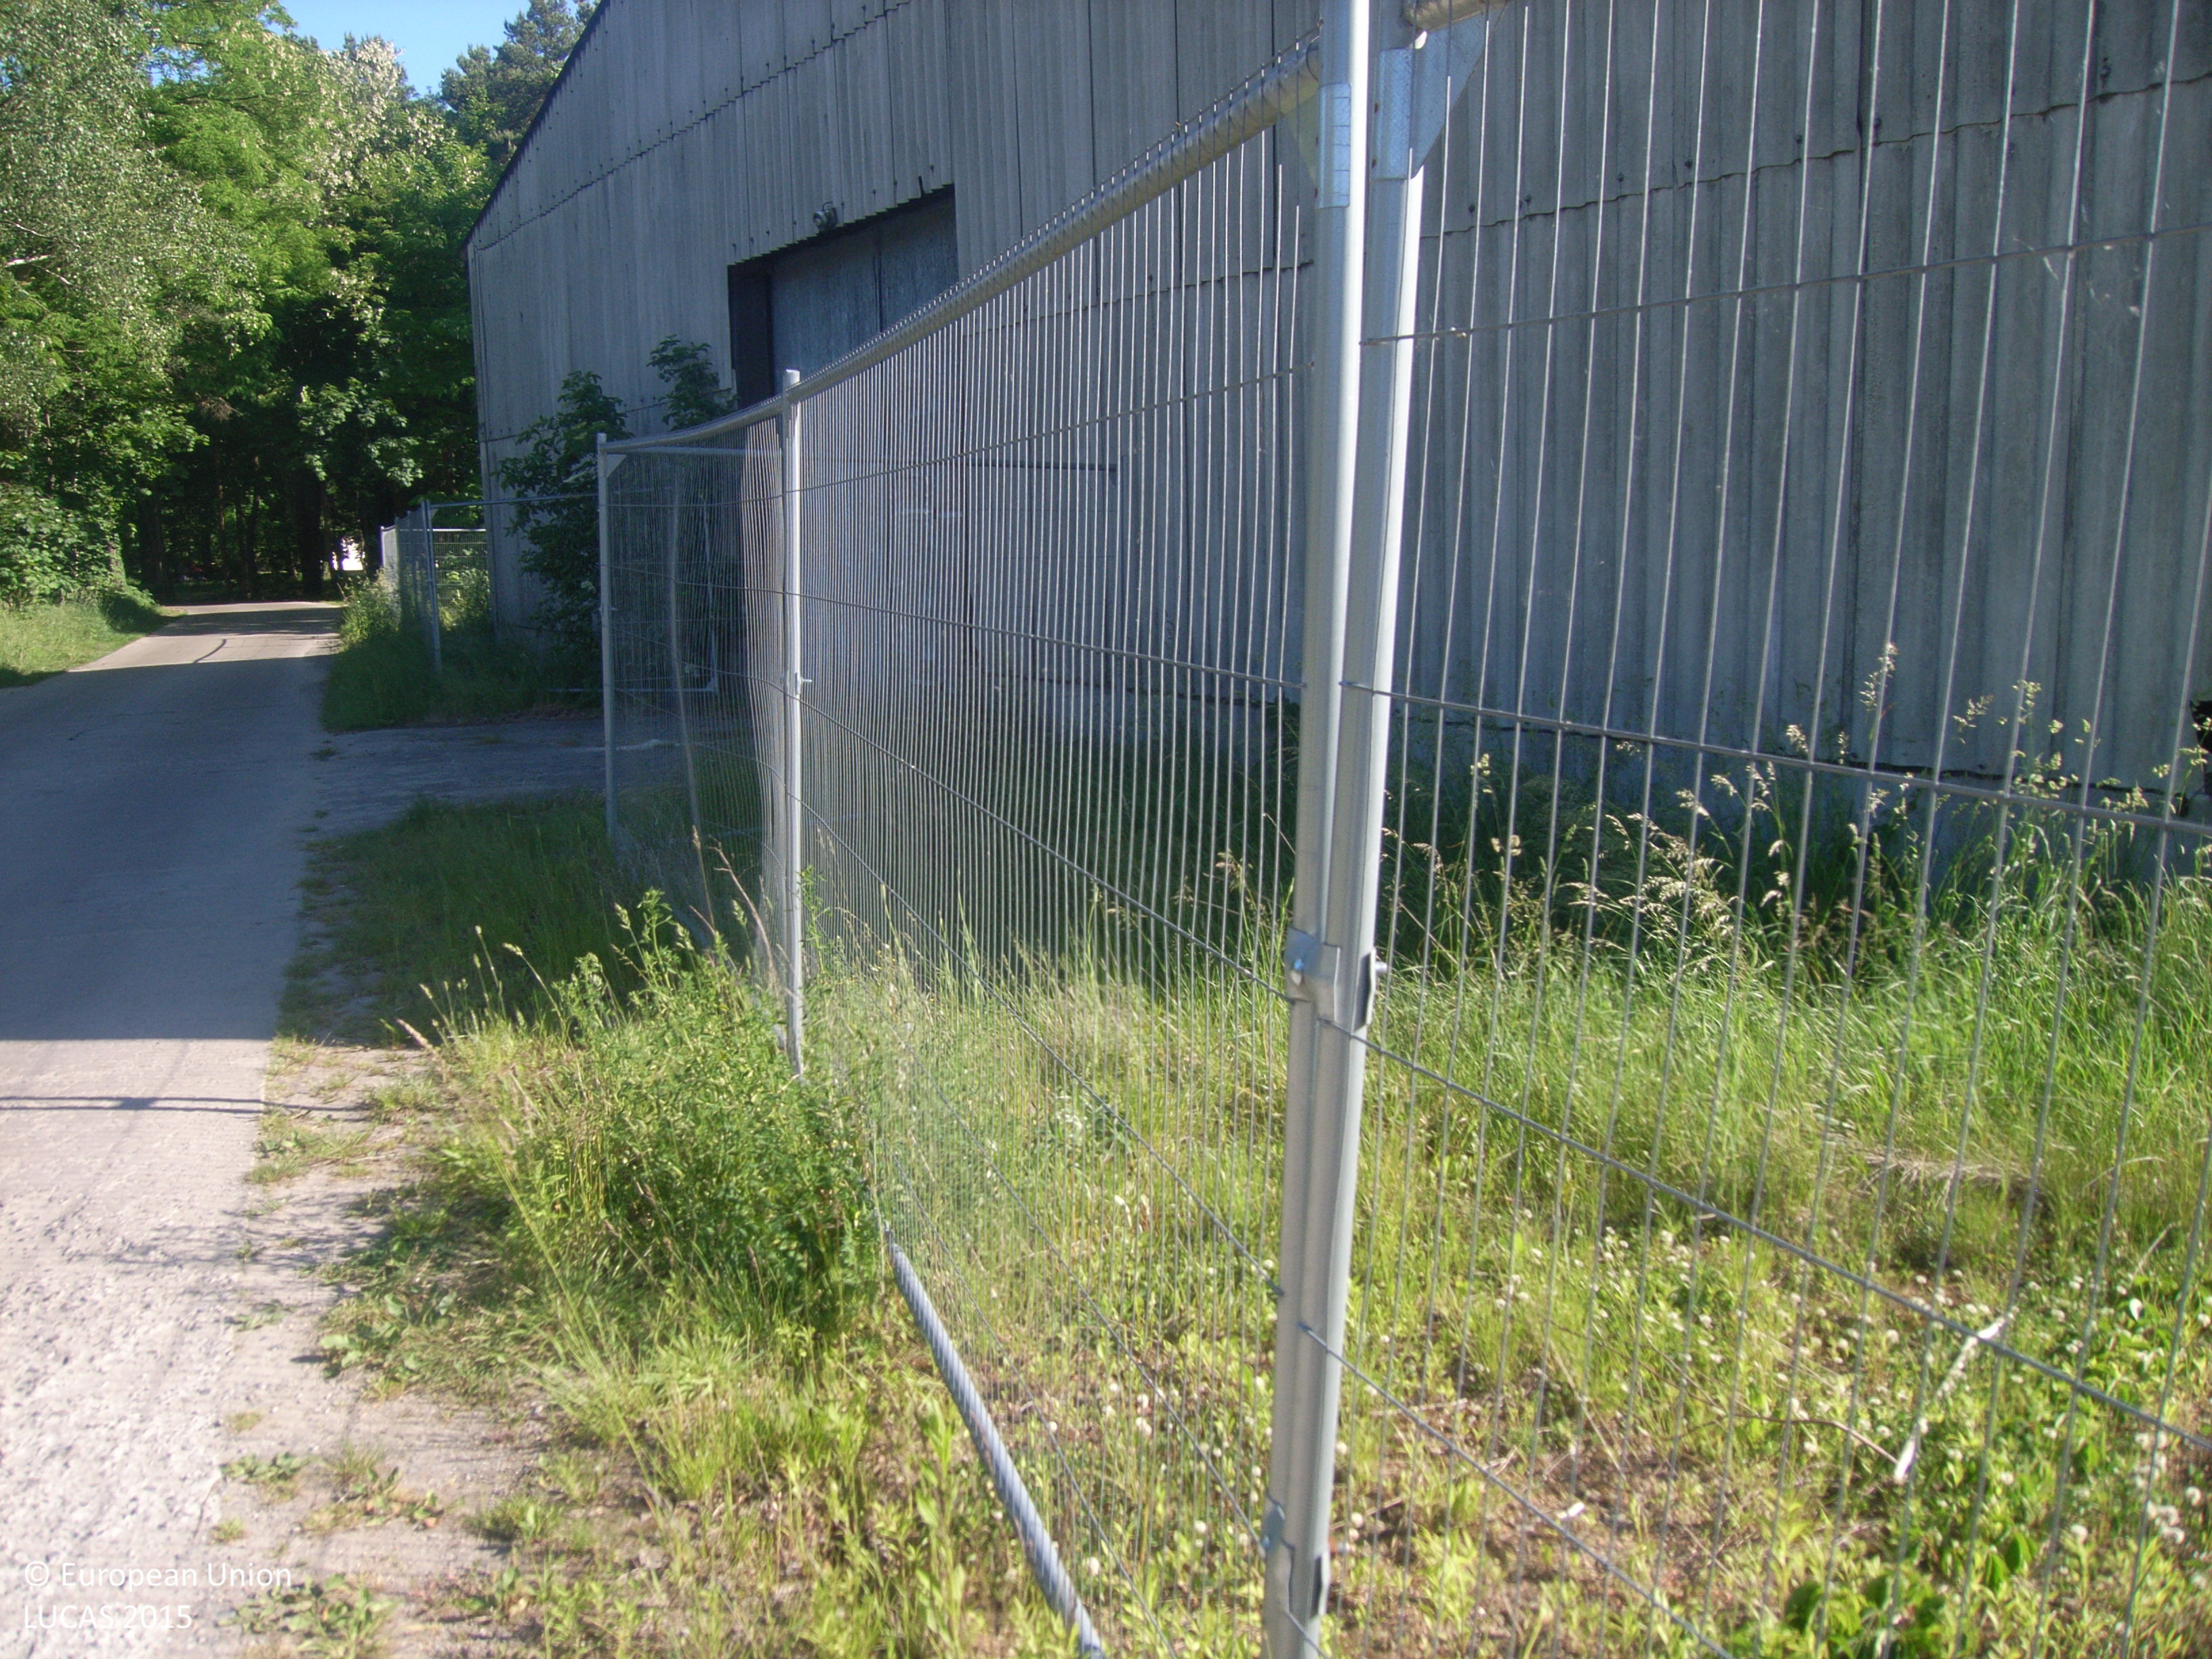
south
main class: Grassland
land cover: Grassland without tree/shrub cover
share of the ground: > 75 %
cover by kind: herbaceous plants 100 %
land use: Construction
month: June
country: DE
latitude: 52.2416
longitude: 14.4096
